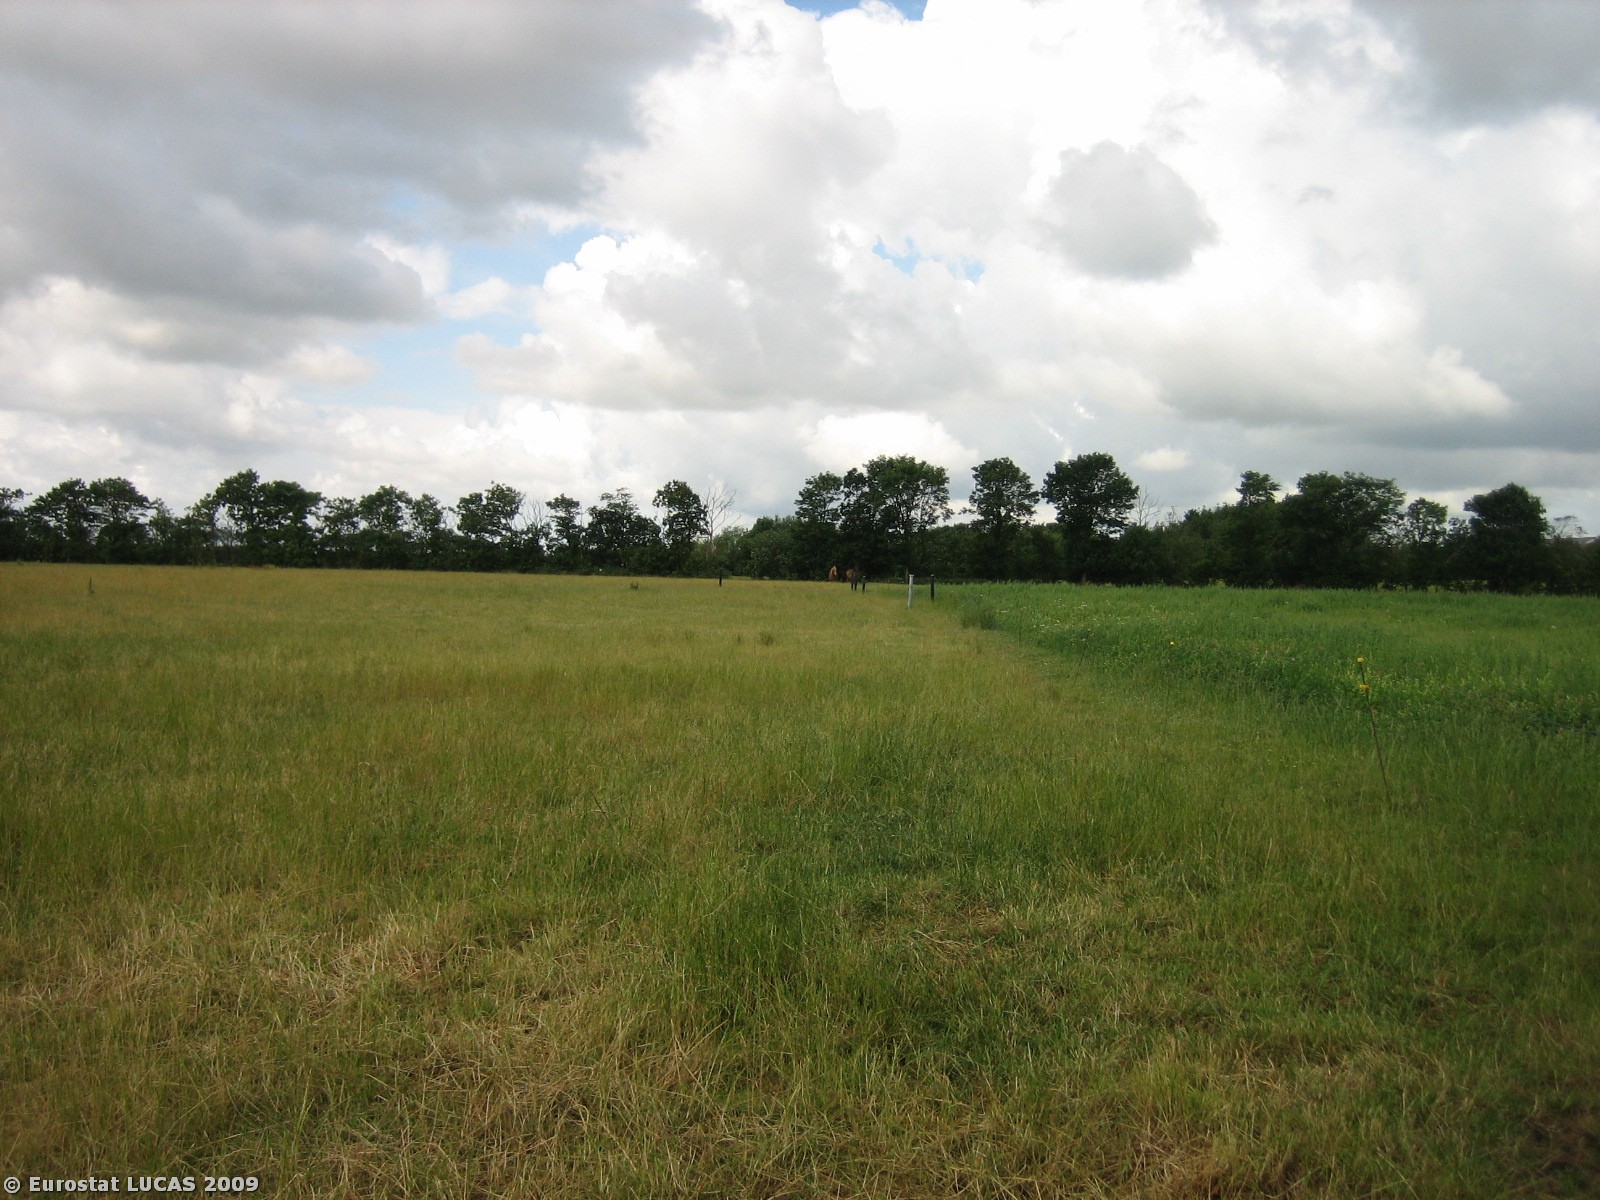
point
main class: Grassland
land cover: Grassland without tree/shrub cover
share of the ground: > 75 %
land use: Agriculture (excluding fallow land and kitchen gardens)
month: July
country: DK
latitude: 55.5680
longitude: 8.5265
